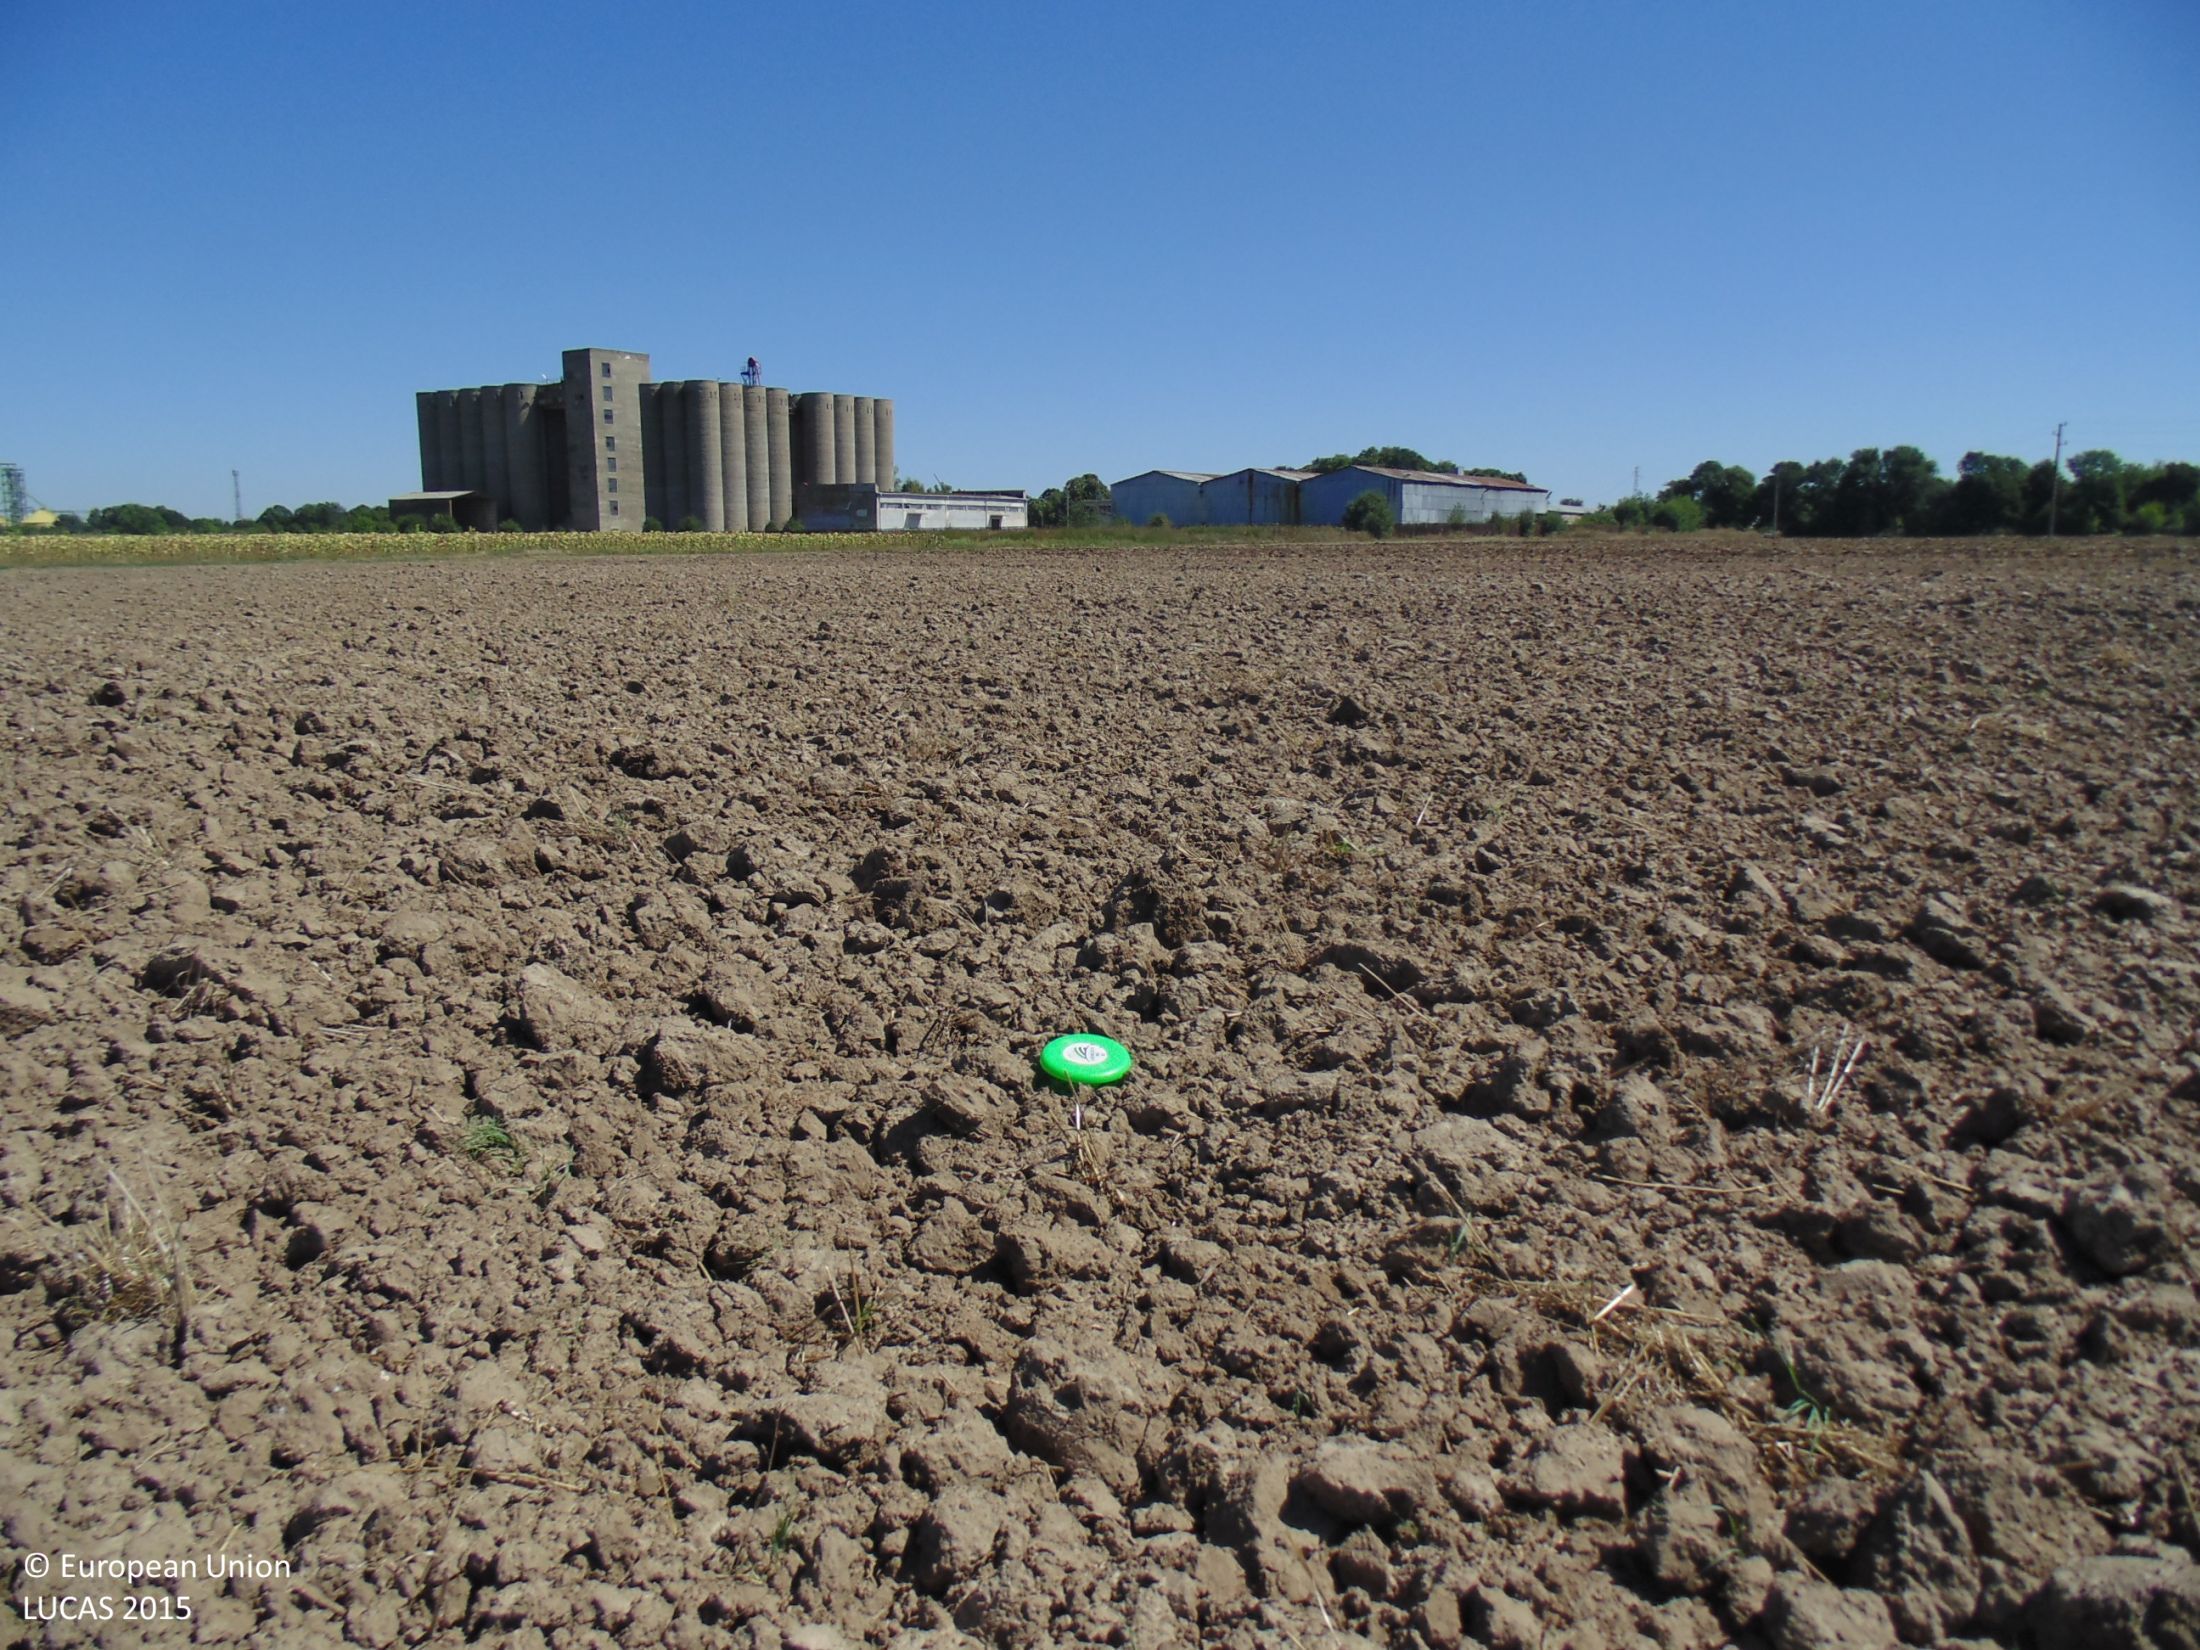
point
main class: Cropland
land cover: Common wheat
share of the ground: < 10 %
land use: Agriculture (excluding fallow land and kitchen gardens)
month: September
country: BG
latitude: 43.7952
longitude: 27.1389
